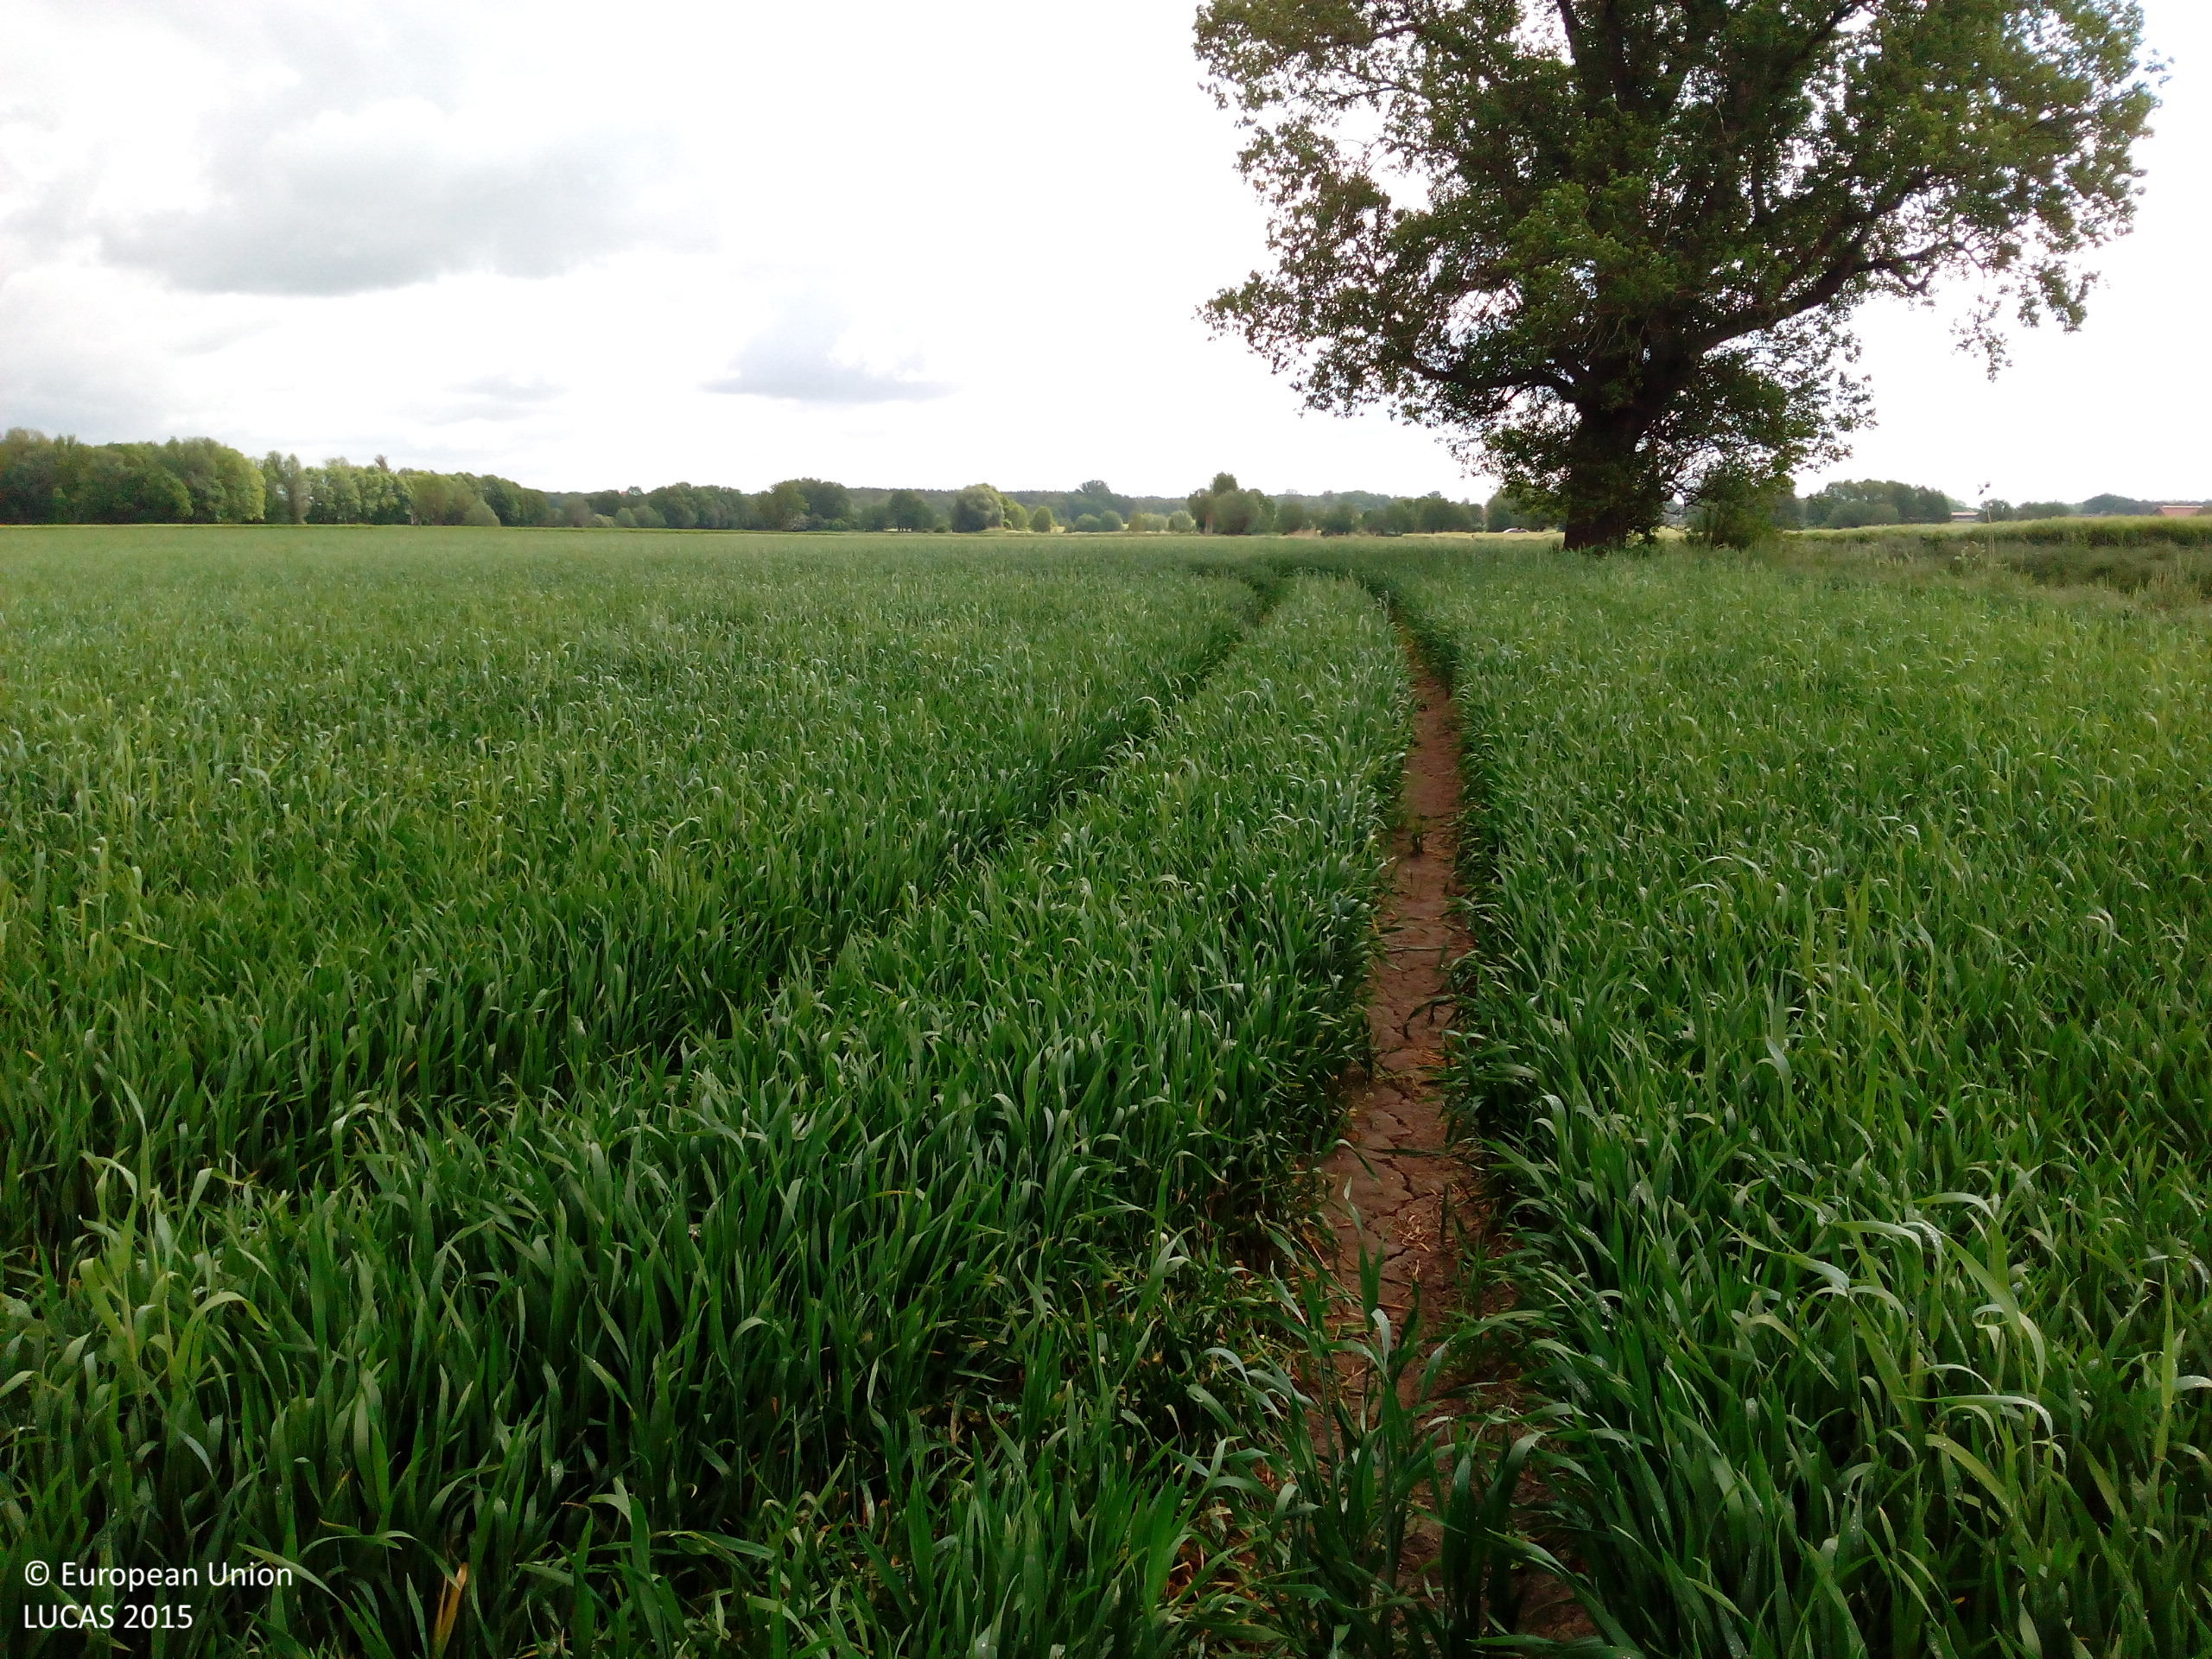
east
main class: Cropland
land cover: Rape and turnip rape
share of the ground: > 75 %
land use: Agriculture (excluding fallow land and kitchen gardens)
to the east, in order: Rape and turnip rape; Triticale; Single bushes/trees; Triticale; Maize; Lucerne
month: May
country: DE
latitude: 52.7085
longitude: 11.5832
